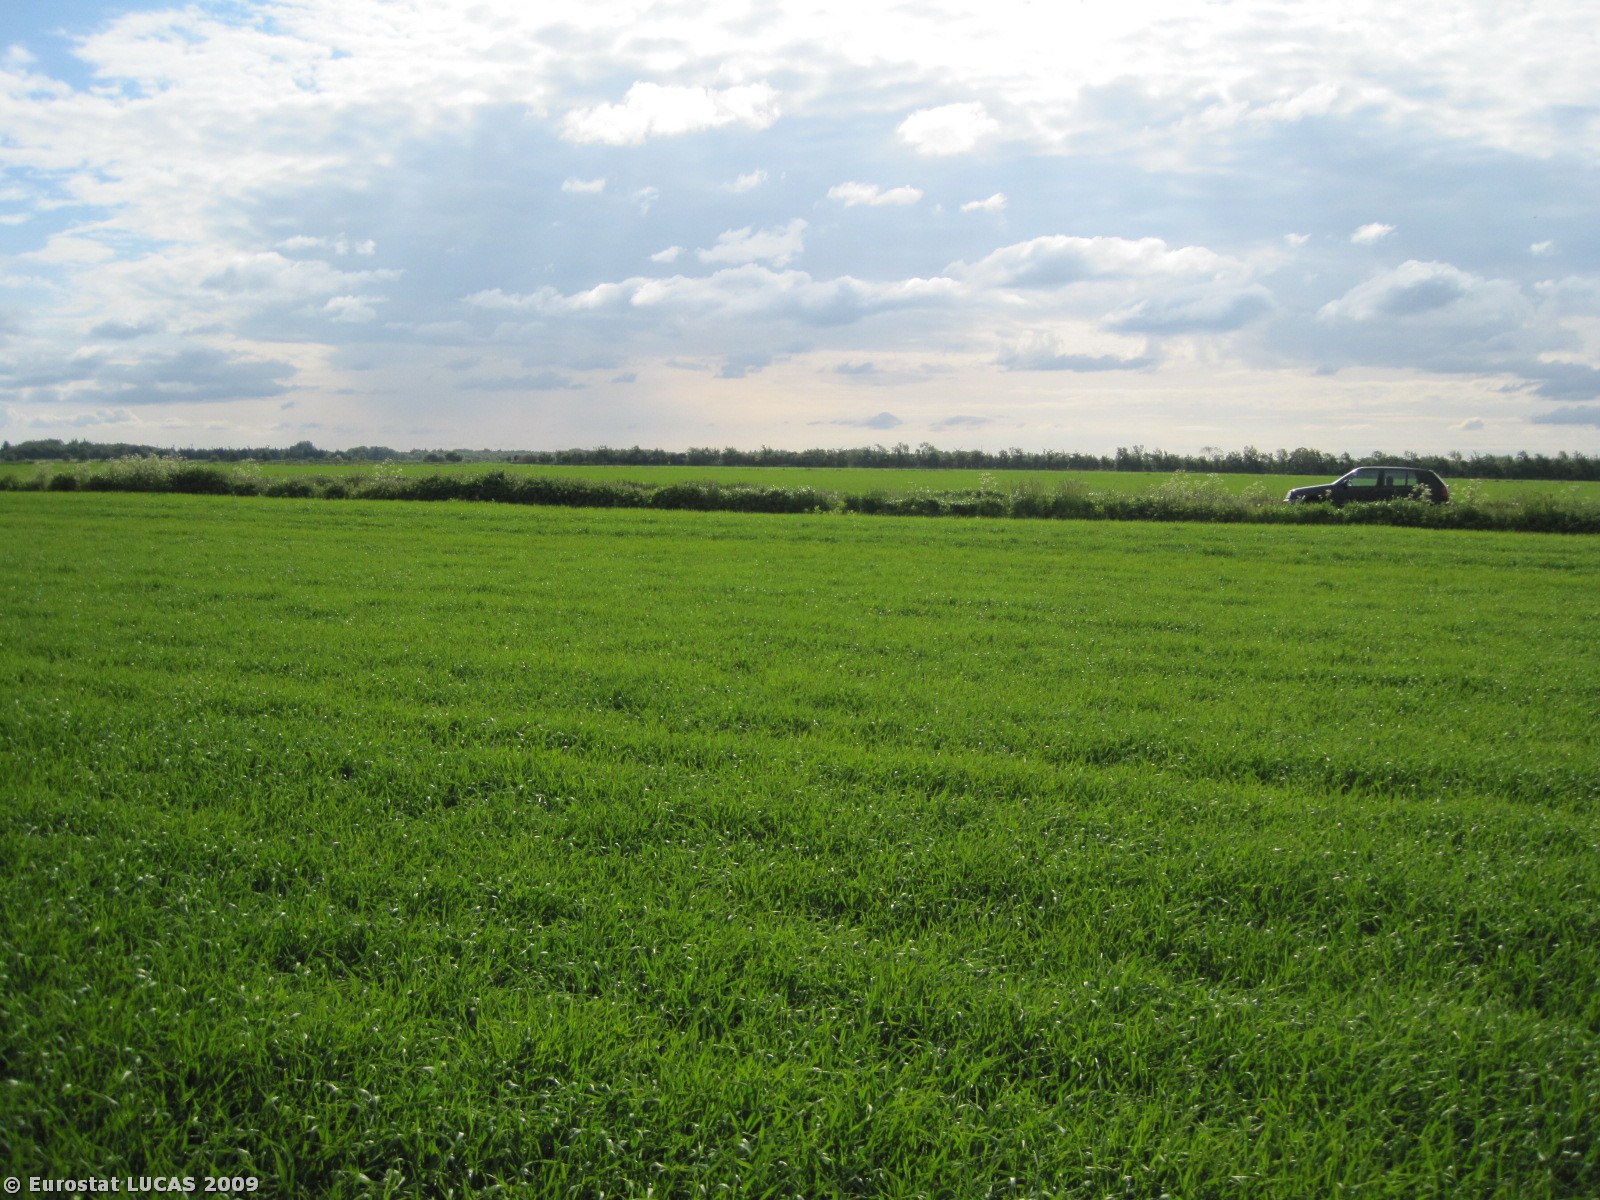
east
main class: Cropland
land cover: Barley
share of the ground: > 75 %
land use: Agriculture (excluding fallow land and kitchen gardens)
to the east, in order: Barley; Grass margins; Tracks; Grass margins; Ditches and canals; Grass margins; Barley
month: June
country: DK
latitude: 57.2123
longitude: 9.8182
